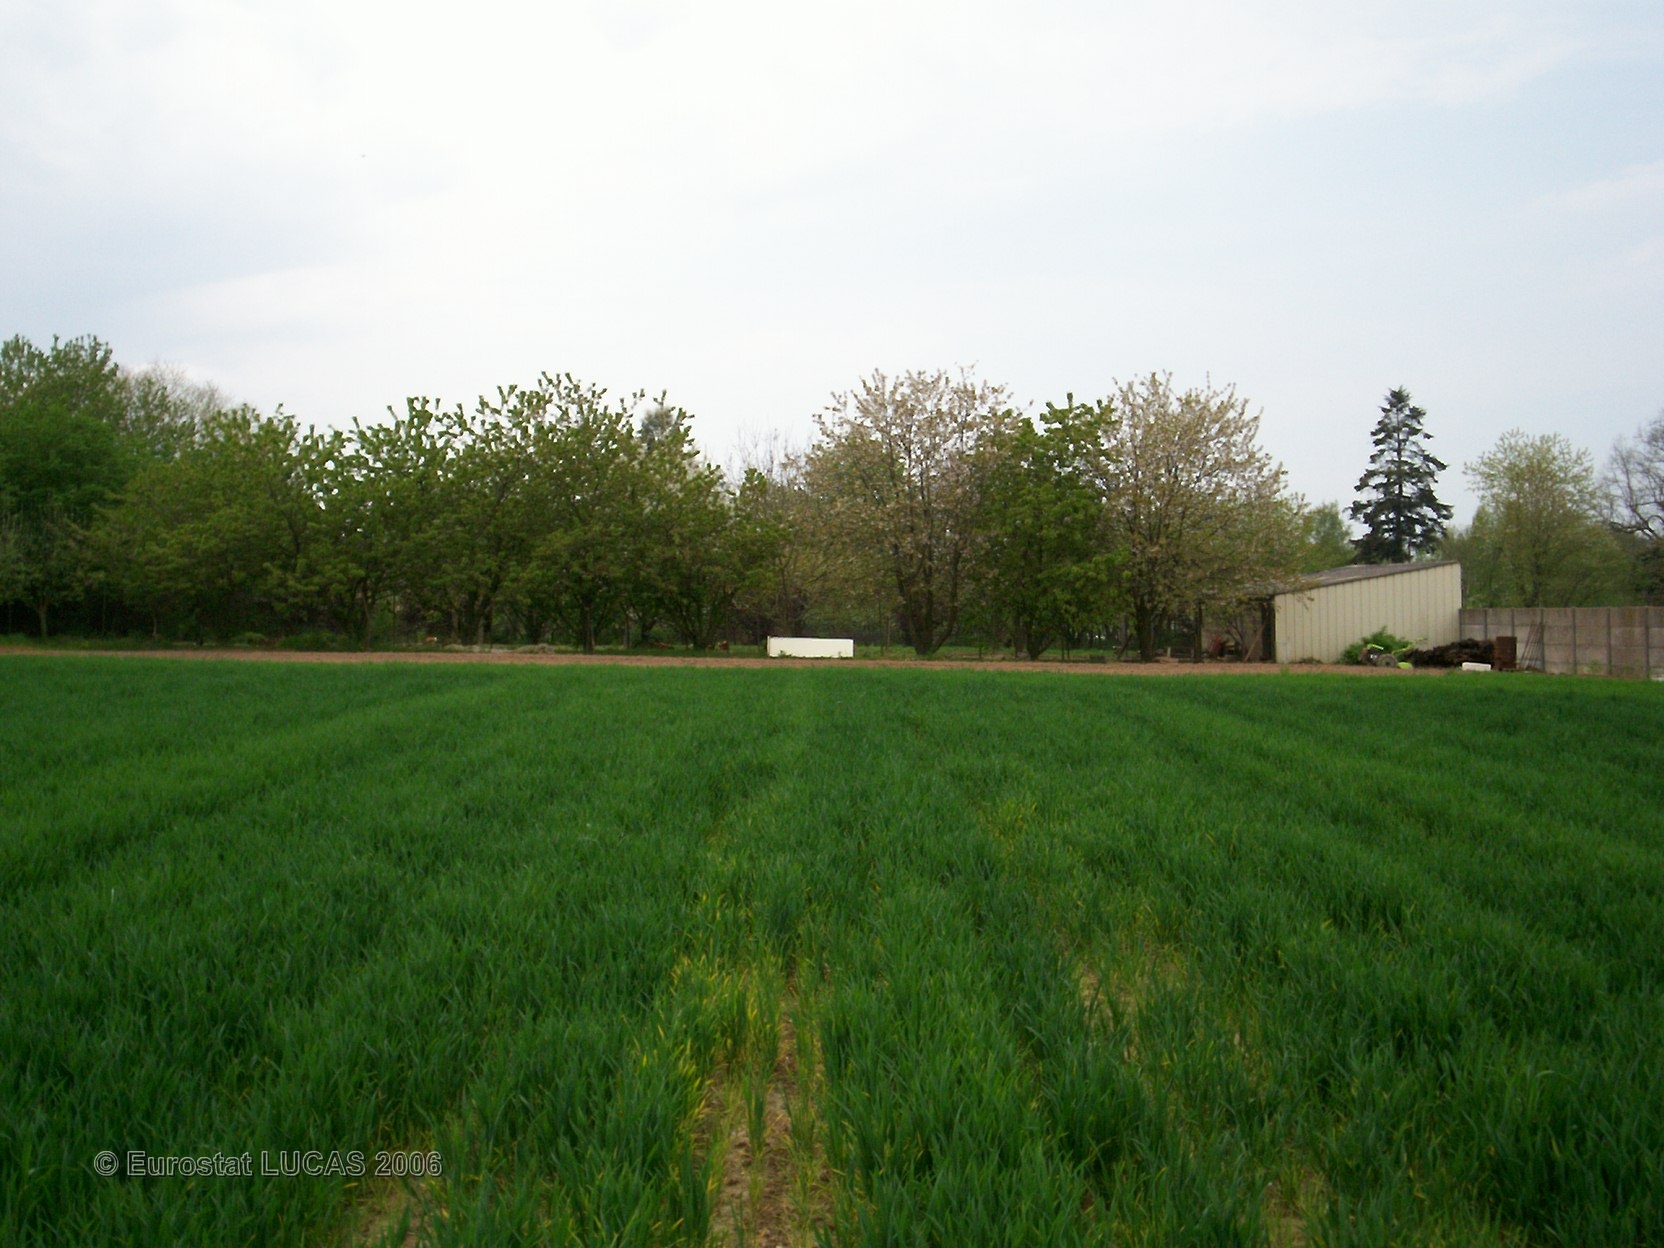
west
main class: Cropland
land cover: Common wheat
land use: Agriculture (excluding fallow land and kitchen gardens)
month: May
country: FR
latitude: 47.8477
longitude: -2.7174
